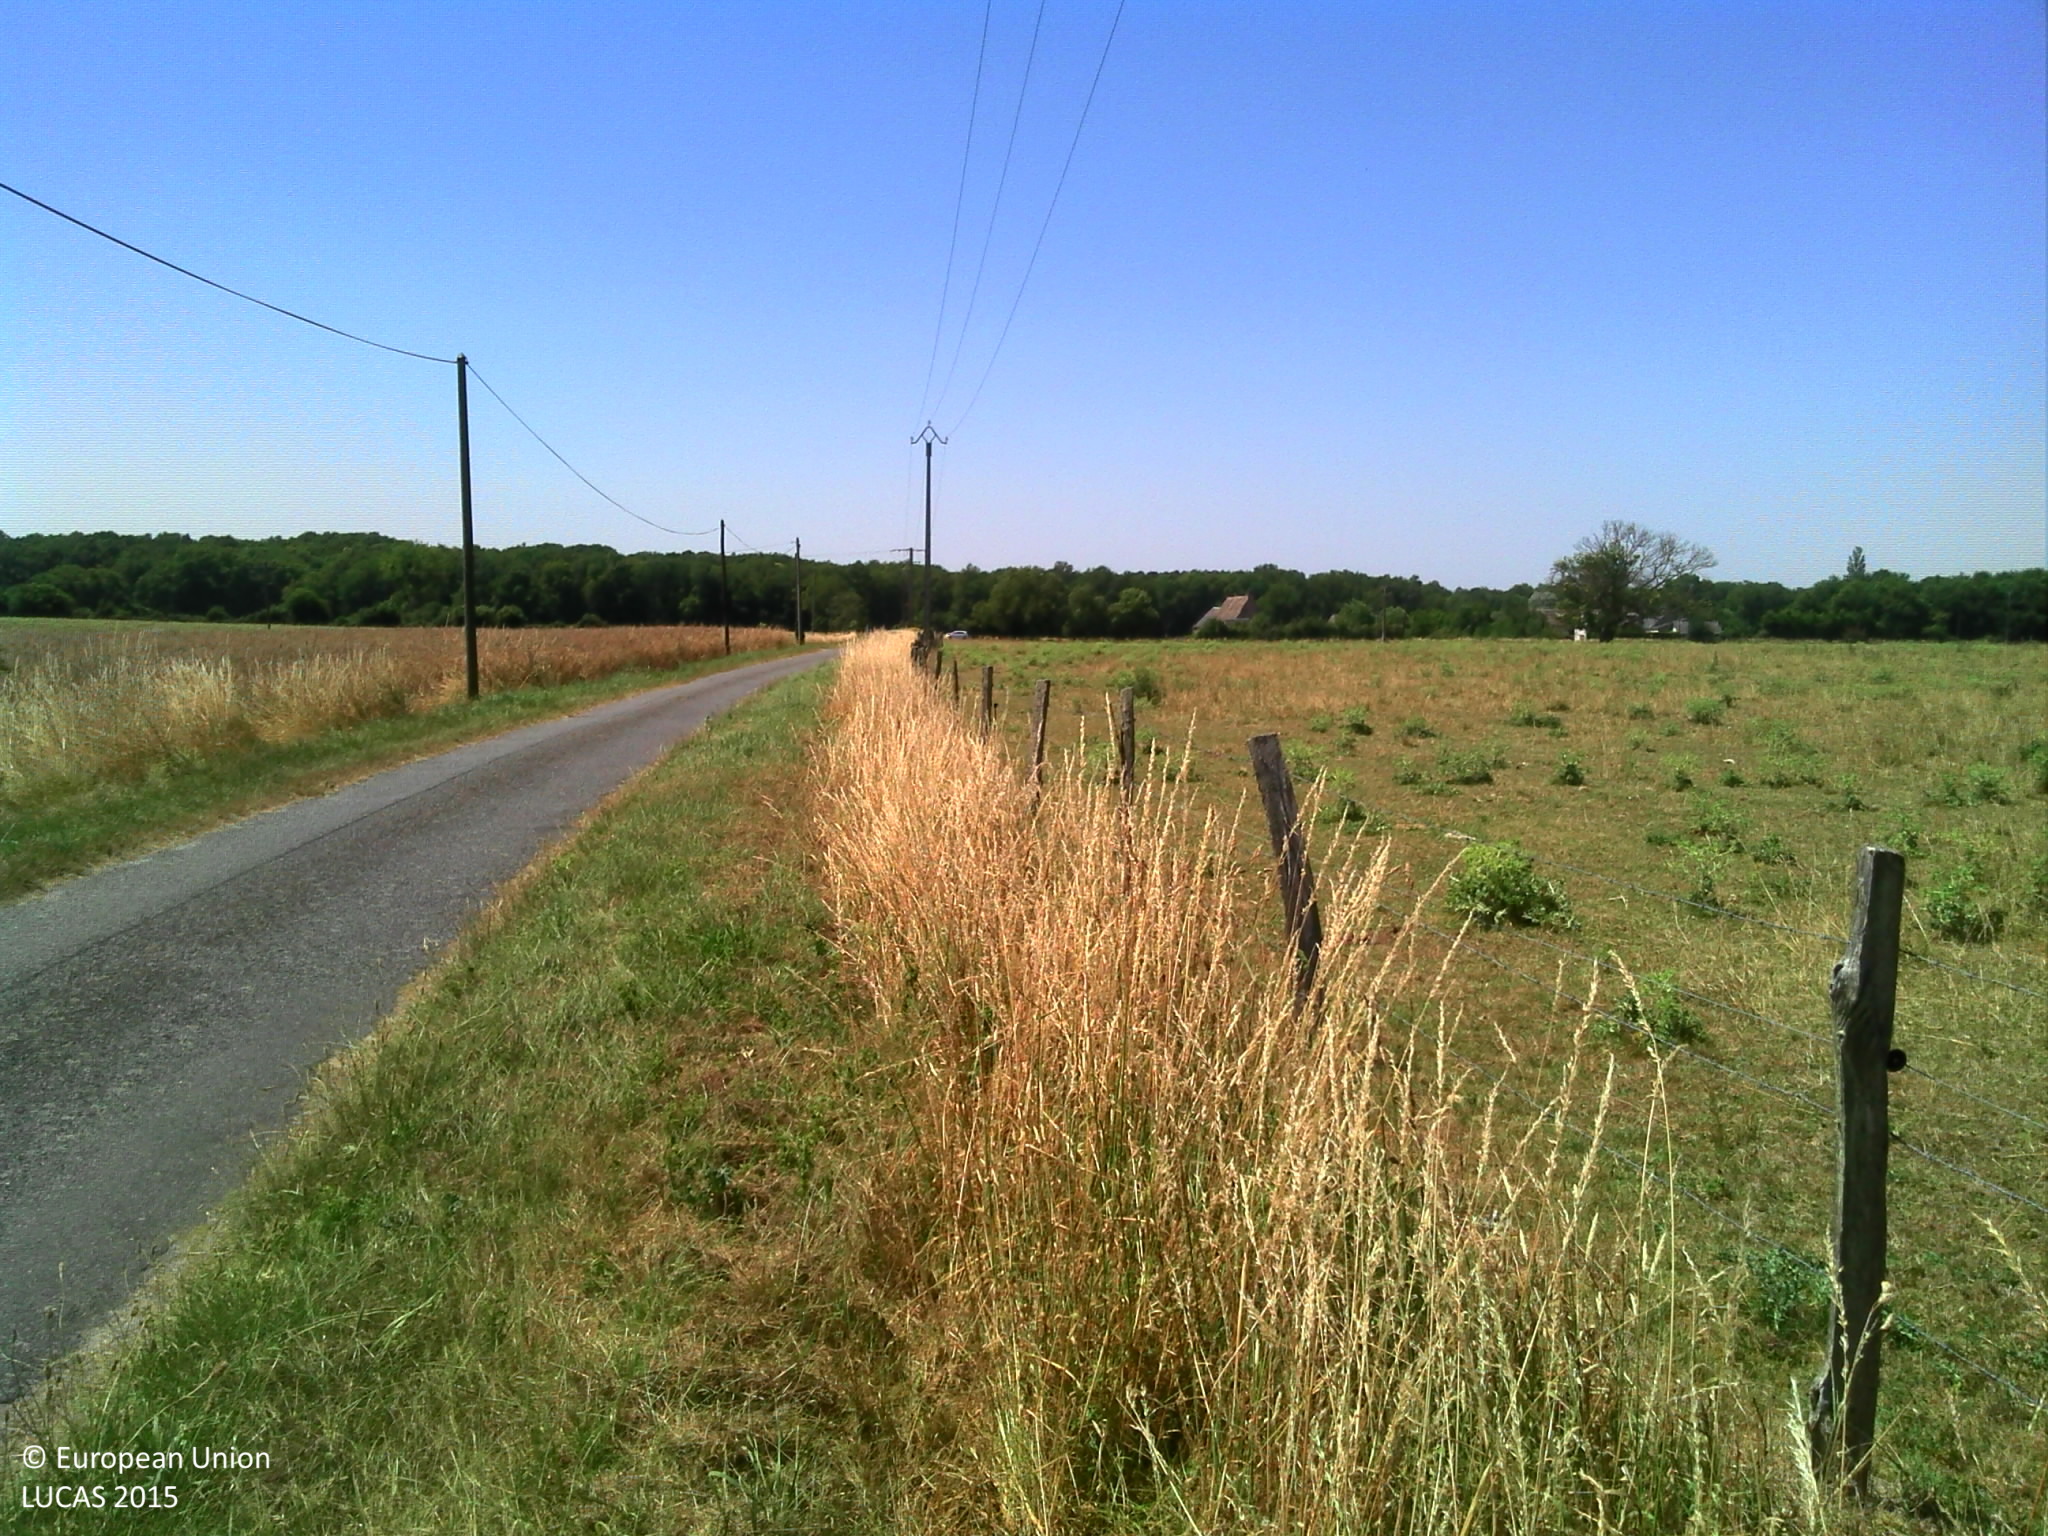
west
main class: Grassland
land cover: Grassland without tree/shrub cover
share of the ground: > 75 %
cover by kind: herbaceous plants 100 %
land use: Agriculture (excluding fallow land and kitchen gardens)
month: June
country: FR
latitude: 47.3869
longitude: 0.4006
